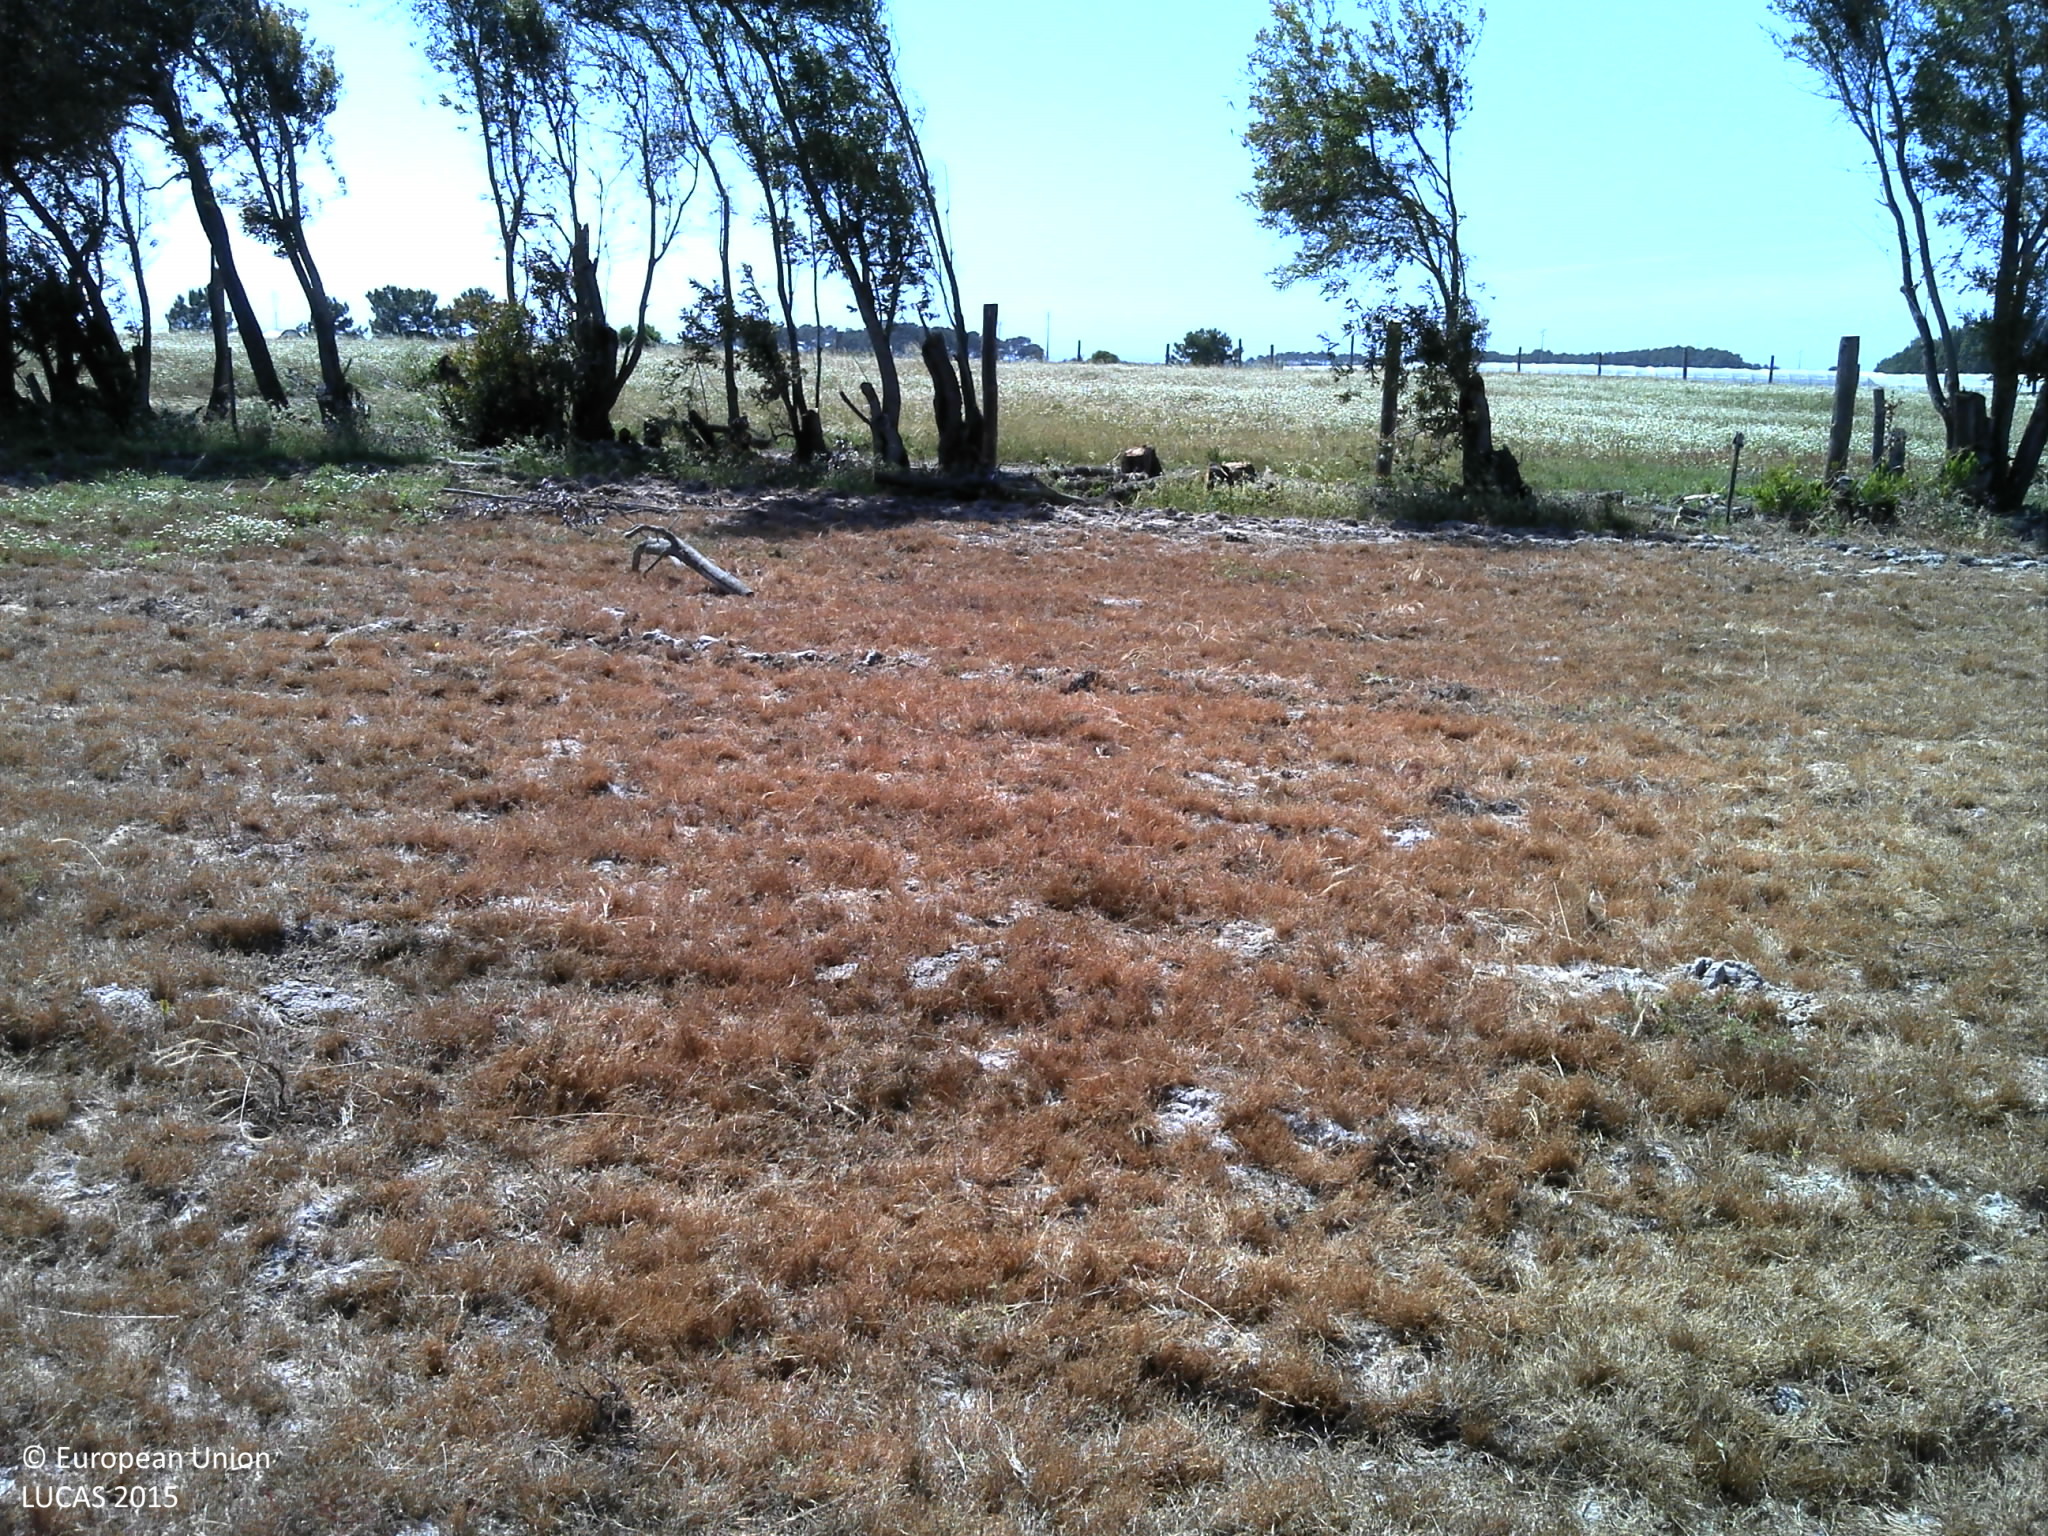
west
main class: Grassland
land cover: Grassland without tree/shrub cover
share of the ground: > 75 %
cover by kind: herbaceous plants 80 %, consolidated bare surface 20 %
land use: Agriculture (excluding fallow land and kitchen gardens)
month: May
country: PT
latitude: 37.5298
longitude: -8.7679
